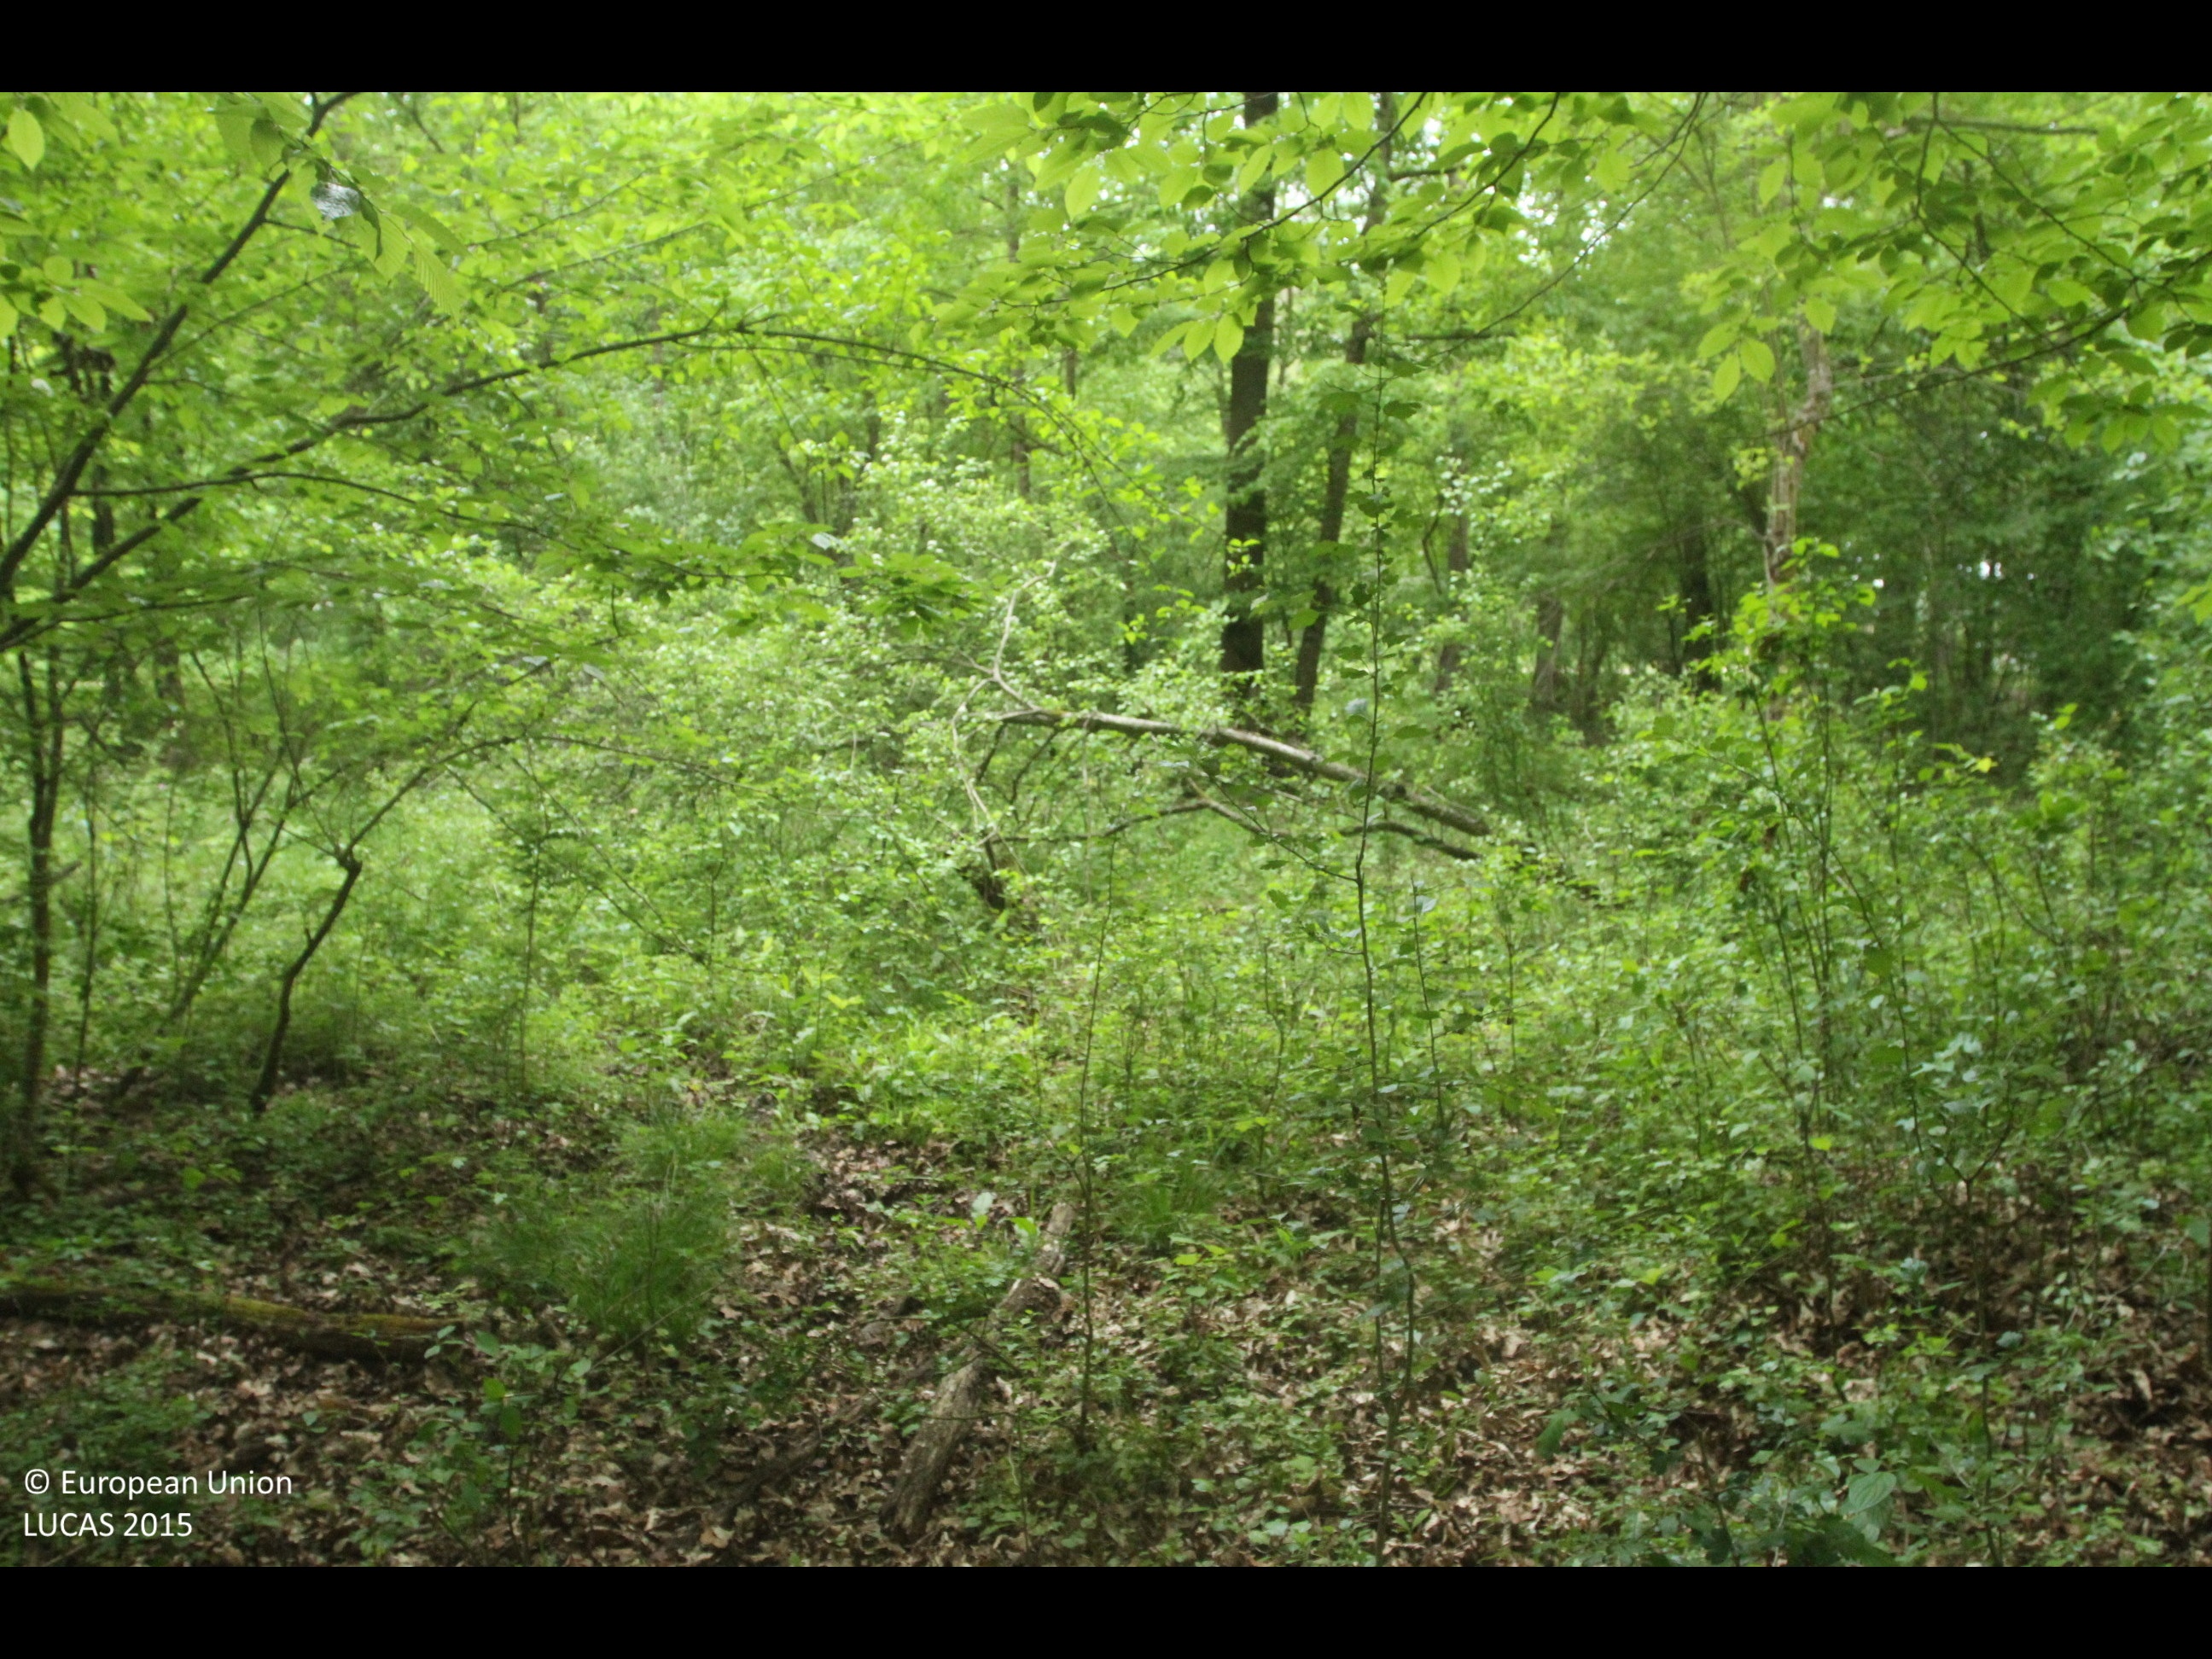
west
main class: Woodland
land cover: Broadleaved woodland
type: mesophytic deciduous forest
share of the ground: > 75 %
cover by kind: broadleaved forest trees 100 %
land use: Forestry
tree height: > 5 m
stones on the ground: < 10 %
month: April
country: HR
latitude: 45.0103
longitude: 19.0031
